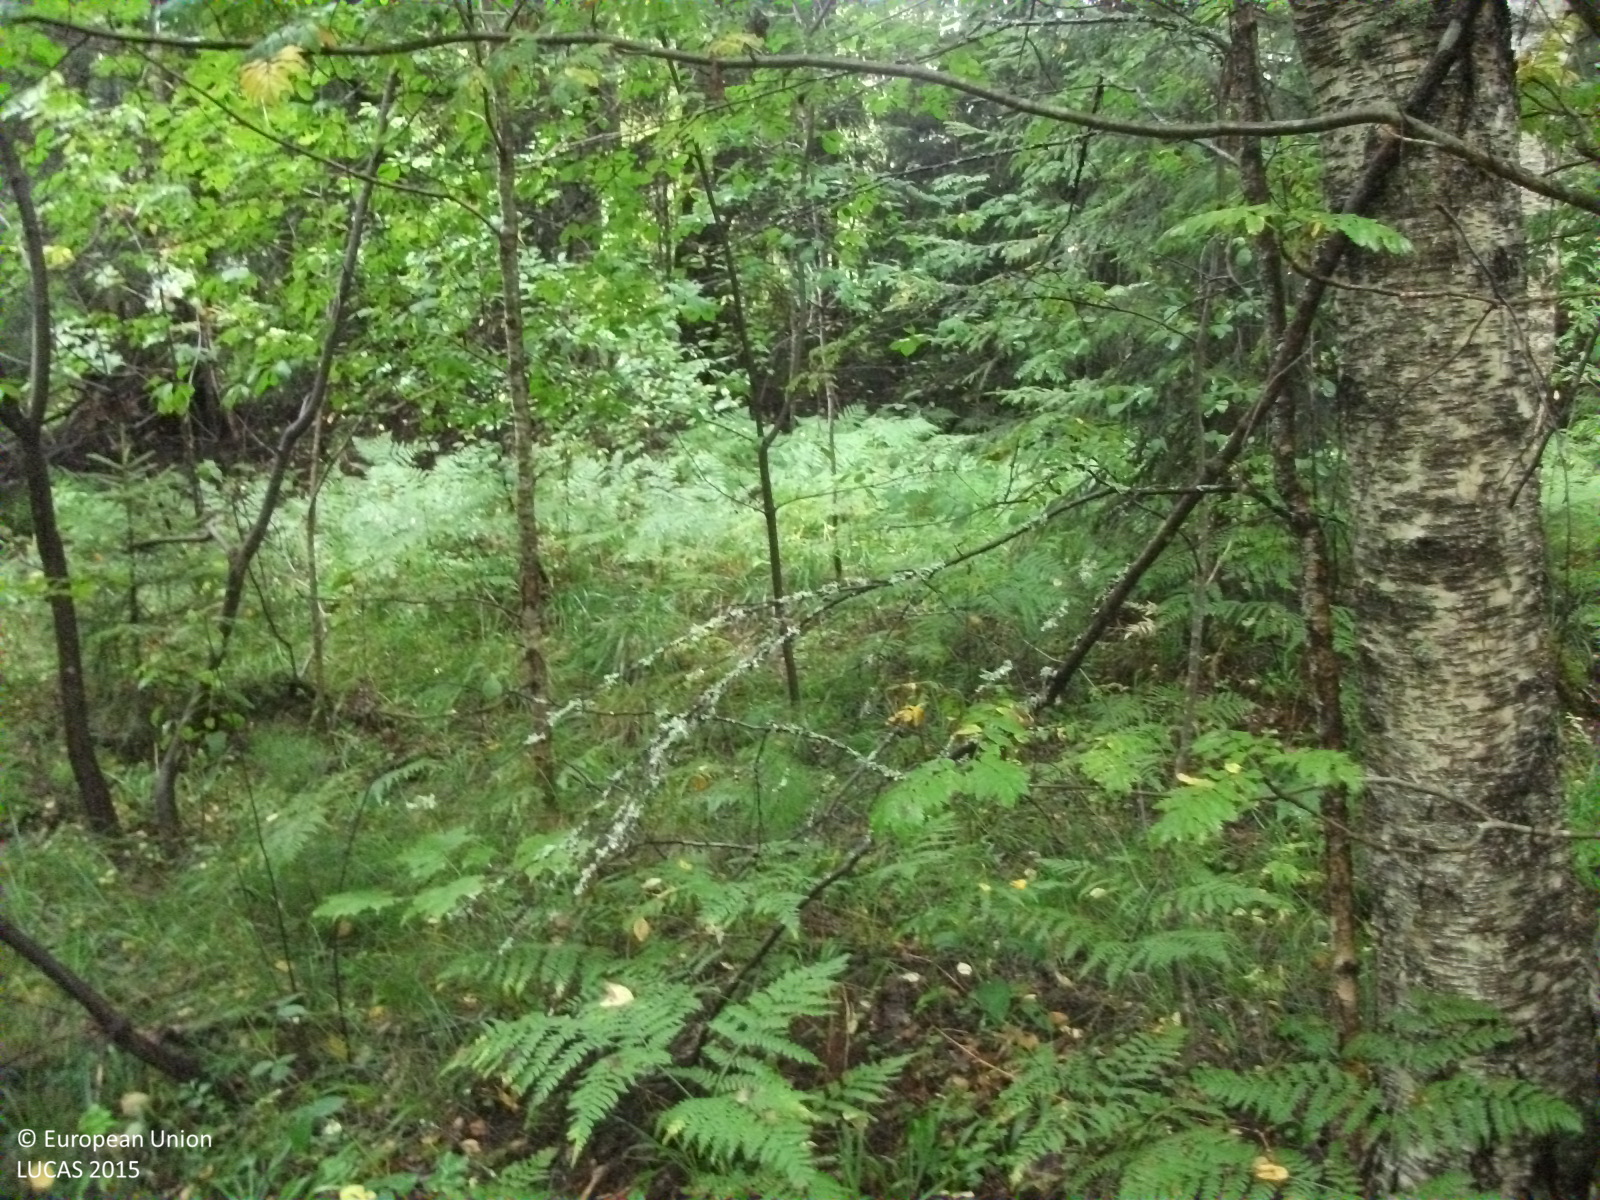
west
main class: Woodland
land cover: Spruce dominated mixed woodland
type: hemiboreal forest and nemoral coniferous forest and mixed broadleaved-coniferous forest
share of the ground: > 75 %
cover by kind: broadleaved forest trees 50 %, coniferous forest trees 25 %, herbaceous plants 15 %, shrubs 10 %
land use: Forestry
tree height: > 5 m
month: September
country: LV
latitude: 57.6085
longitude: 24.8435
